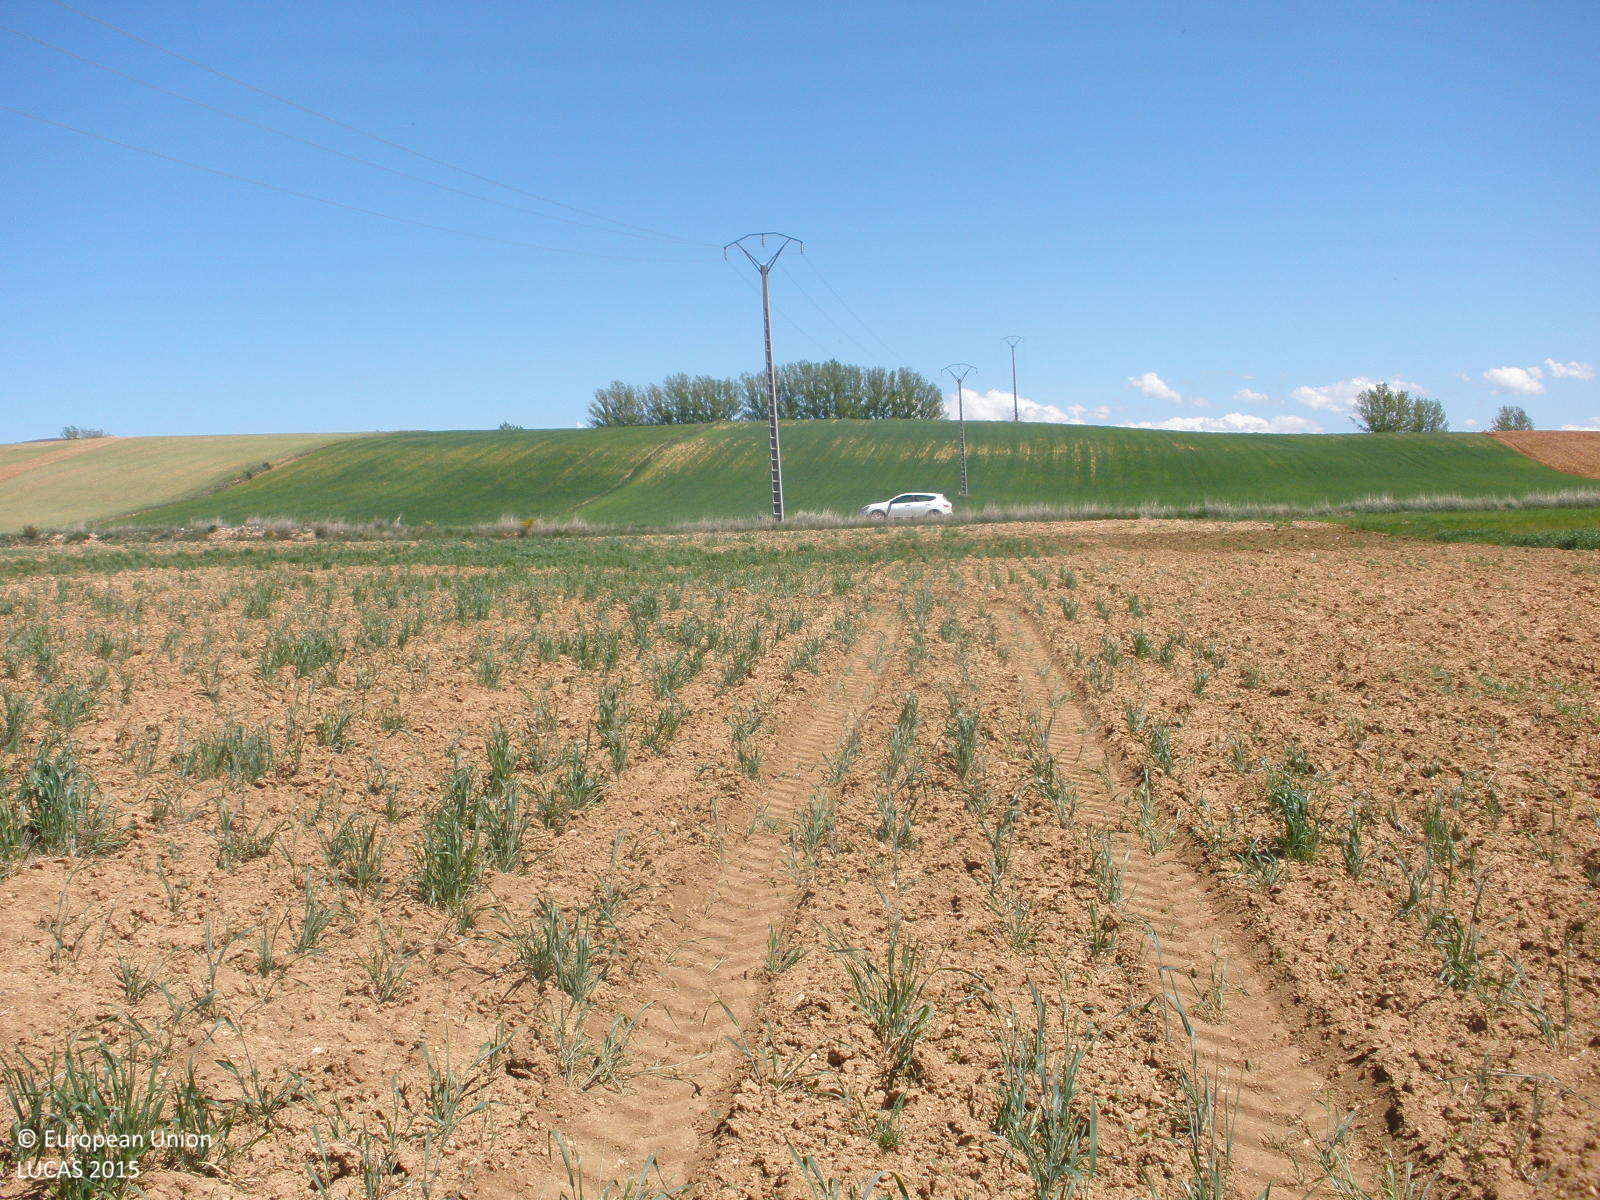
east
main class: Grassland
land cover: Spontaneously vegetated surfaces
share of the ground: 25 - 50 %
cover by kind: herbaceous plants 50 %, unconsolidated bare surface 50 %
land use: Fallow land
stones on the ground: < 10 %
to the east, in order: Spontaneously vegetated surfaces; Electric lines; Spontaneously vegetated surfaces; Grassland without tree/shrub cover; Rivers and streams; Tracks; Grass margins; Common wheat; Grass margins; Spontaneously vegetated surfaces
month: May
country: ES
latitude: 40.7219
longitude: -0.8452
